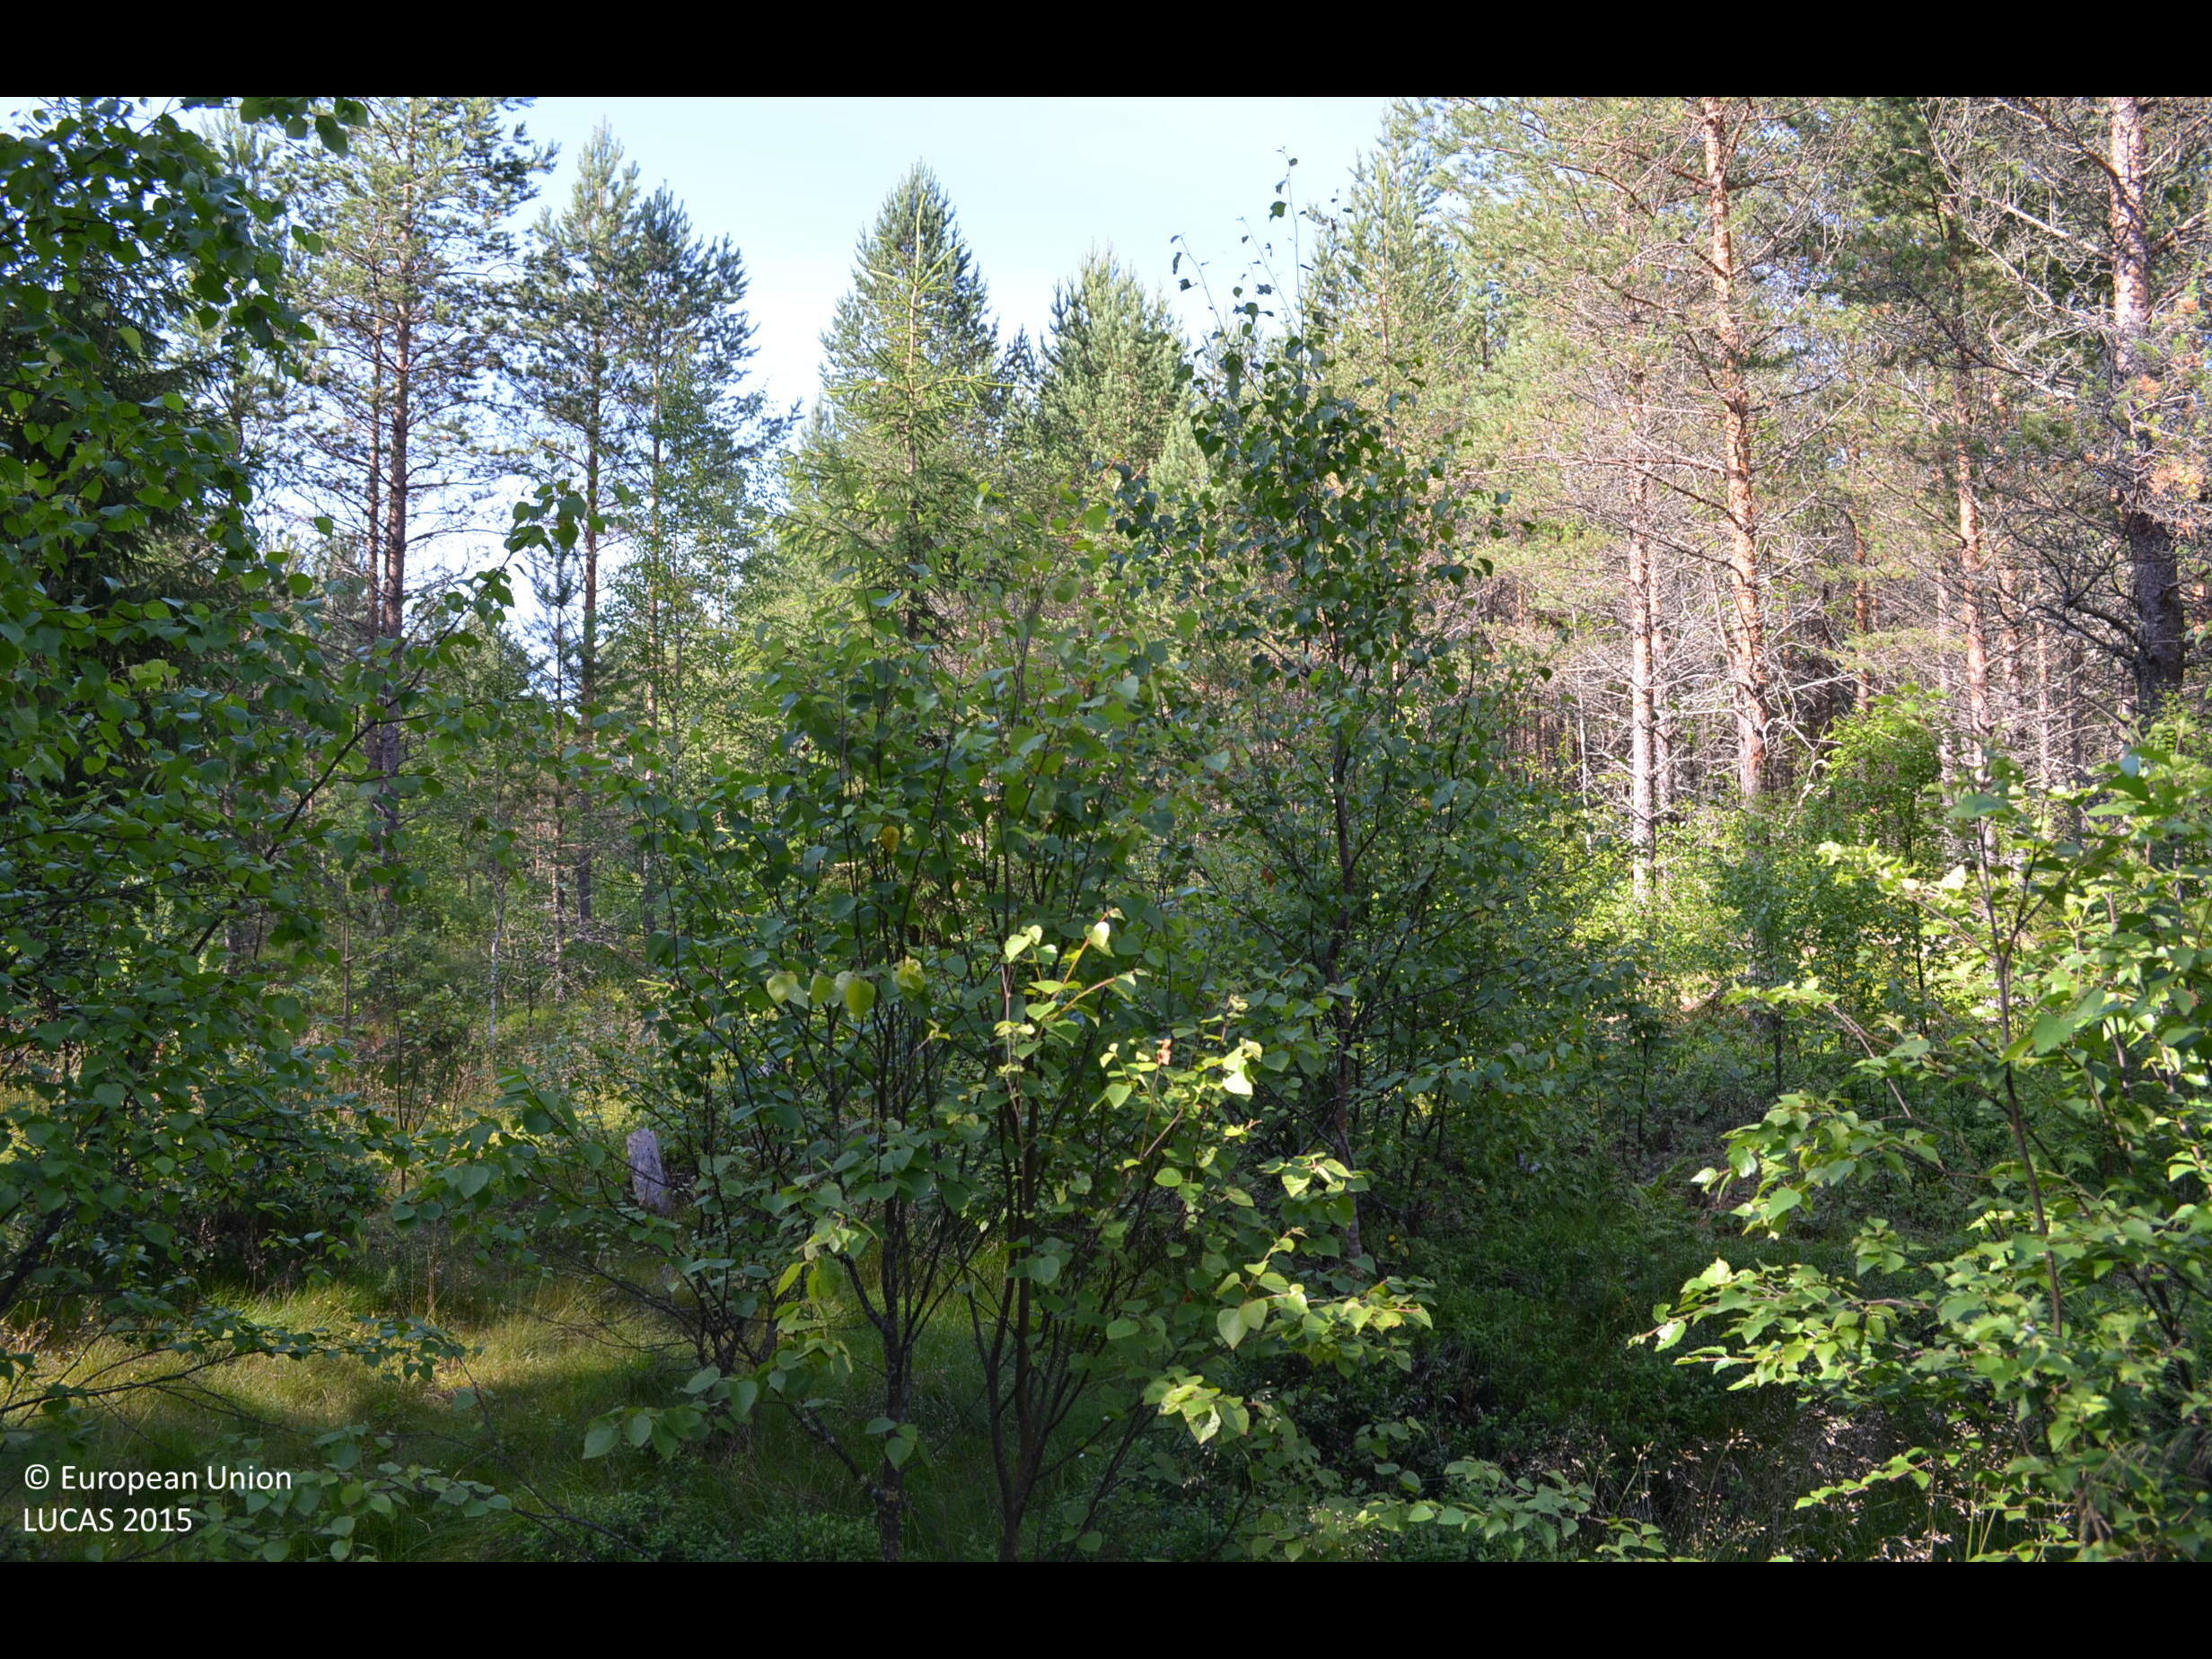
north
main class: Woodland
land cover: Other mixed woodland
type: boreal forest
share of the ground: 50 - 75 %
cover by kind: broadleaved forest trees 45 %, herbaceous plants 25 %, coniferous forest trees 15 %, shrubs 15 %
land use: Forestry
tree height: < 5 m
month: July
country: FI
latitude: 62.1345
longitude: 23.4406
